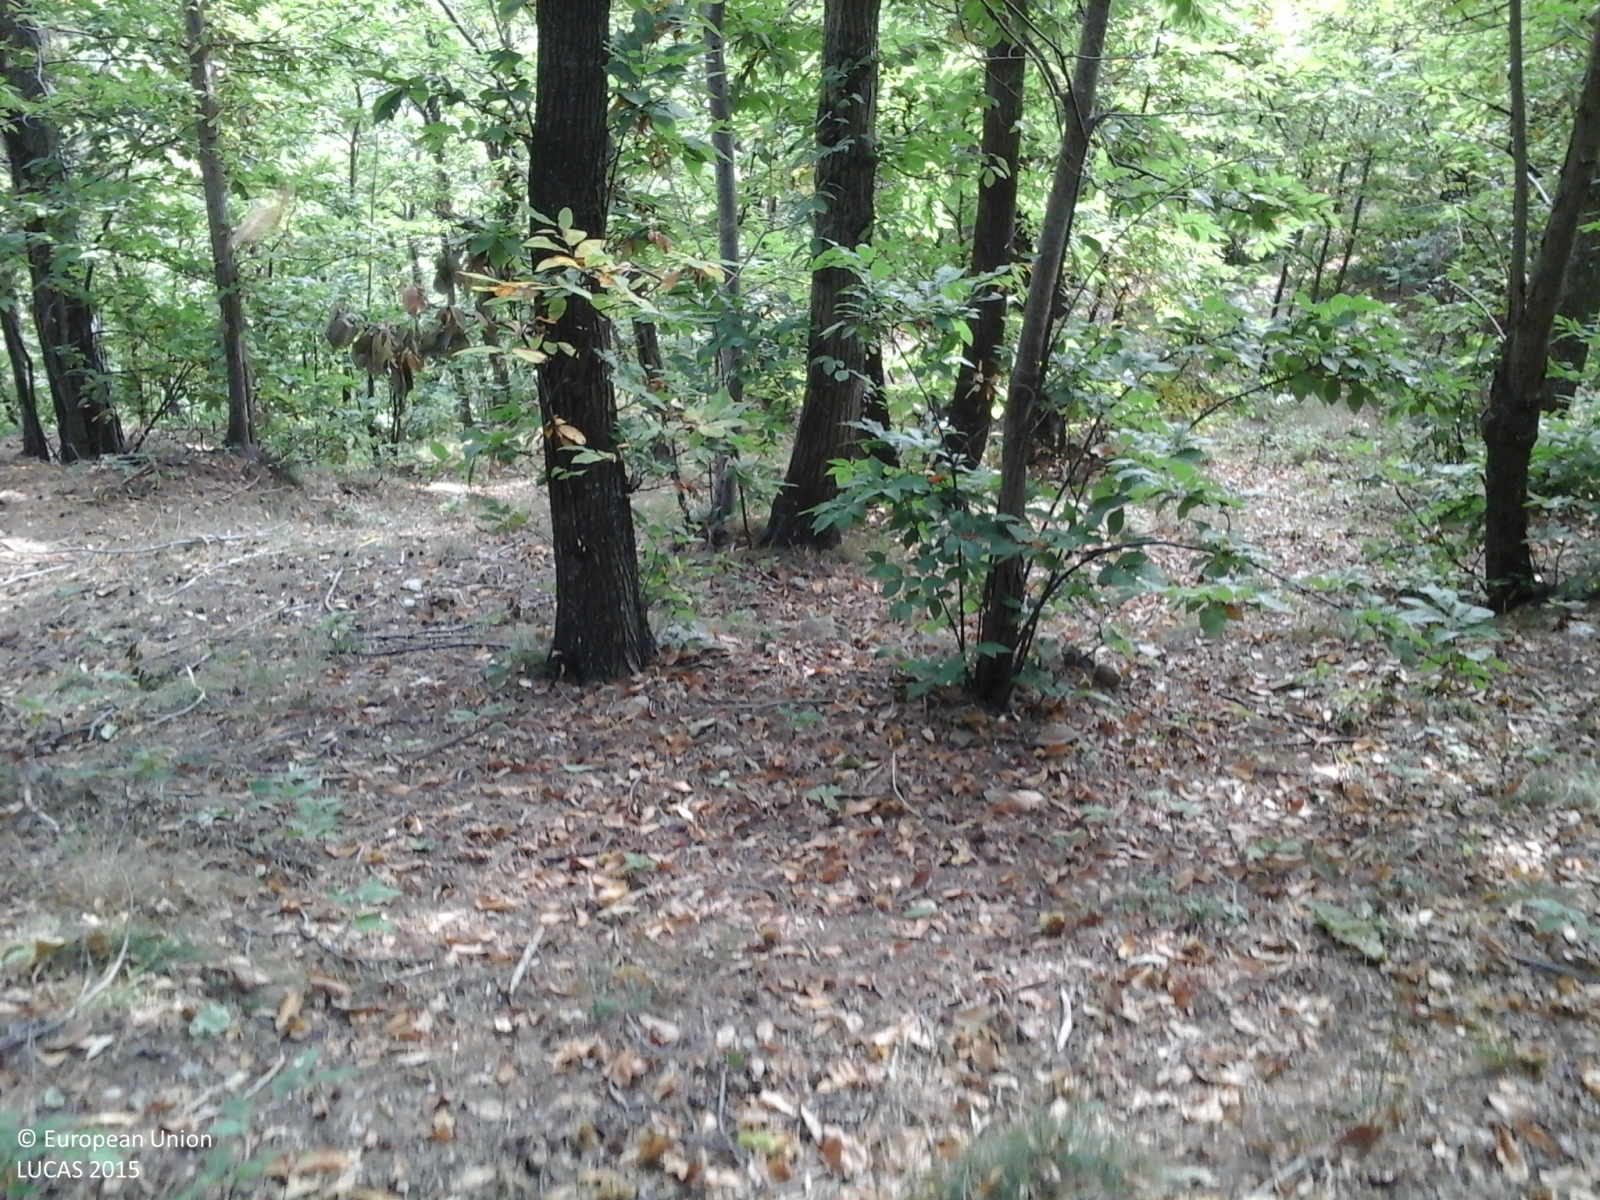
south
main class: Woodland
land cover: Broadleaved woodland
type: thermophilous deciduous forest
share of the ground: > 75 %
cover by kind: broadleaved forest trees 95 %, coniferous forest trees 5 %
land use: Forestry
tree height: > 5 m
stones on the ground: > 50 %
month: September
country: IT
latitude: 44.2815
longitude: 8.2372
